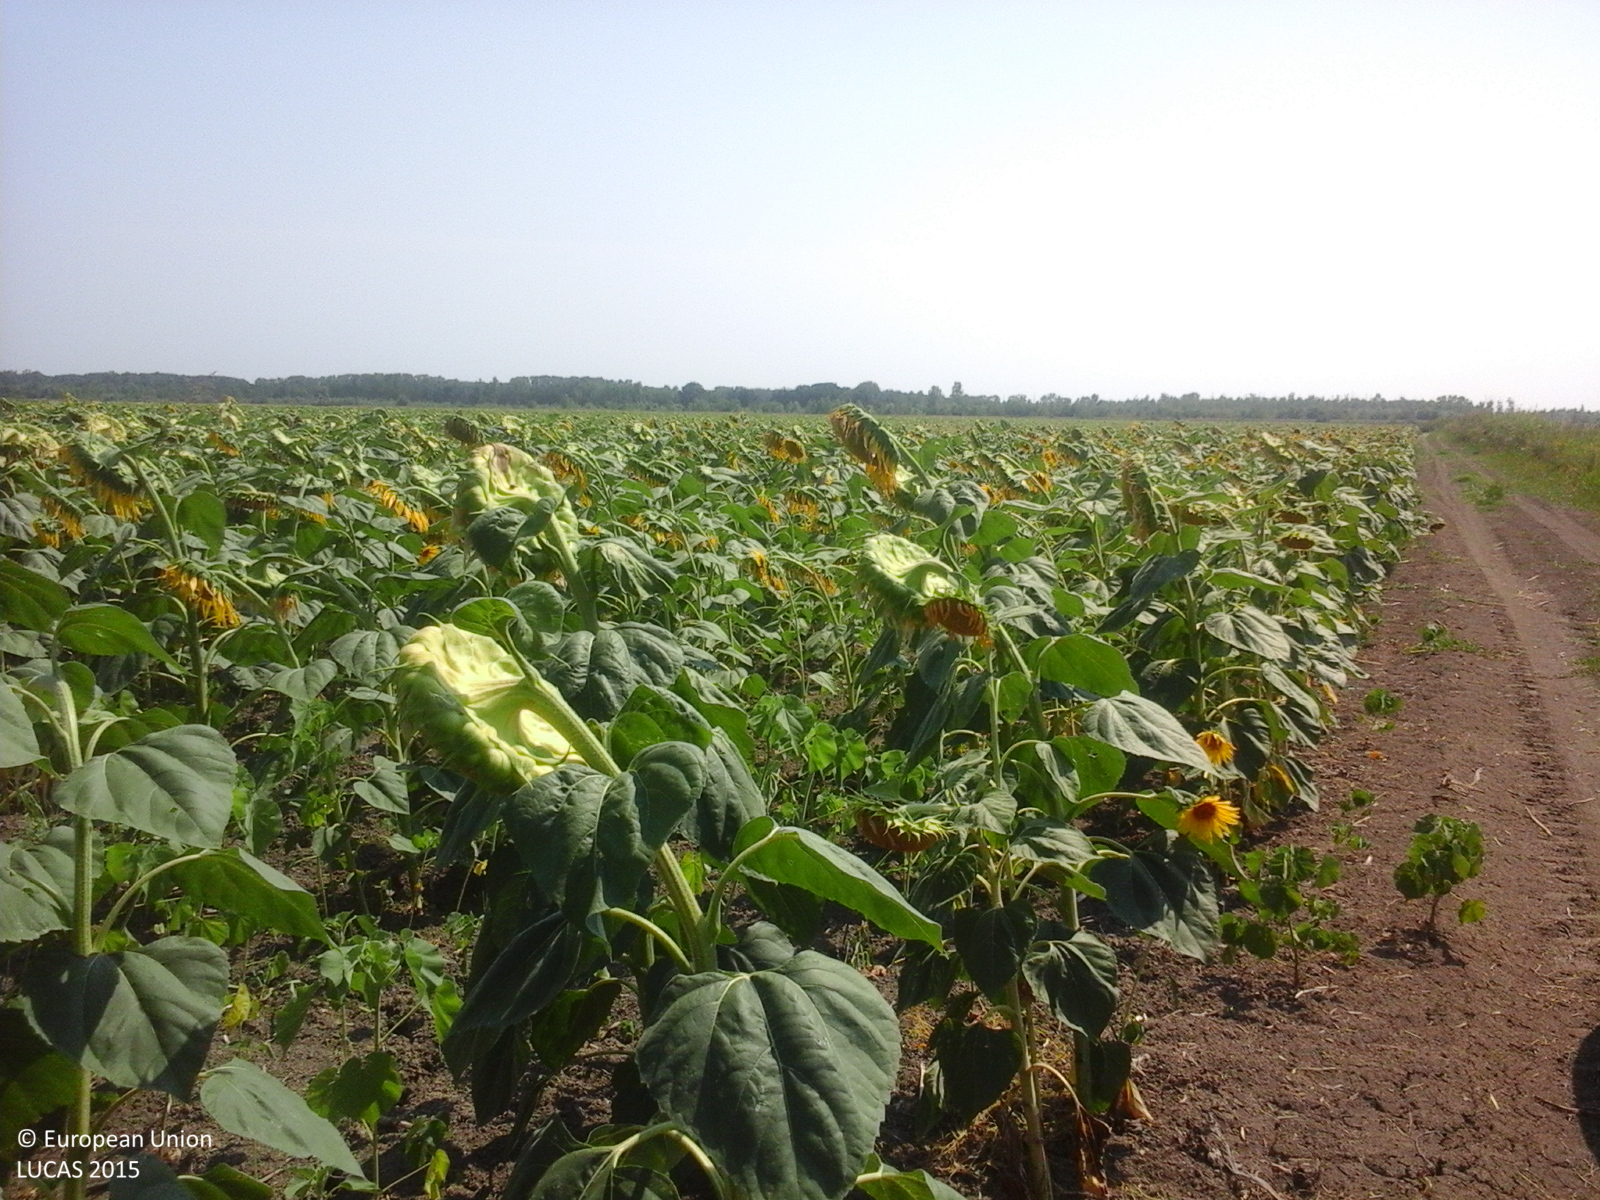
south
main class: Cropland
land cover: Sunflower
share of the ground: > 75 %
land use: Agriculture (excluding fallow land and kitchen gardens)
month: July
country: RO
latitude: 45.4124
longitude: 27.8082
